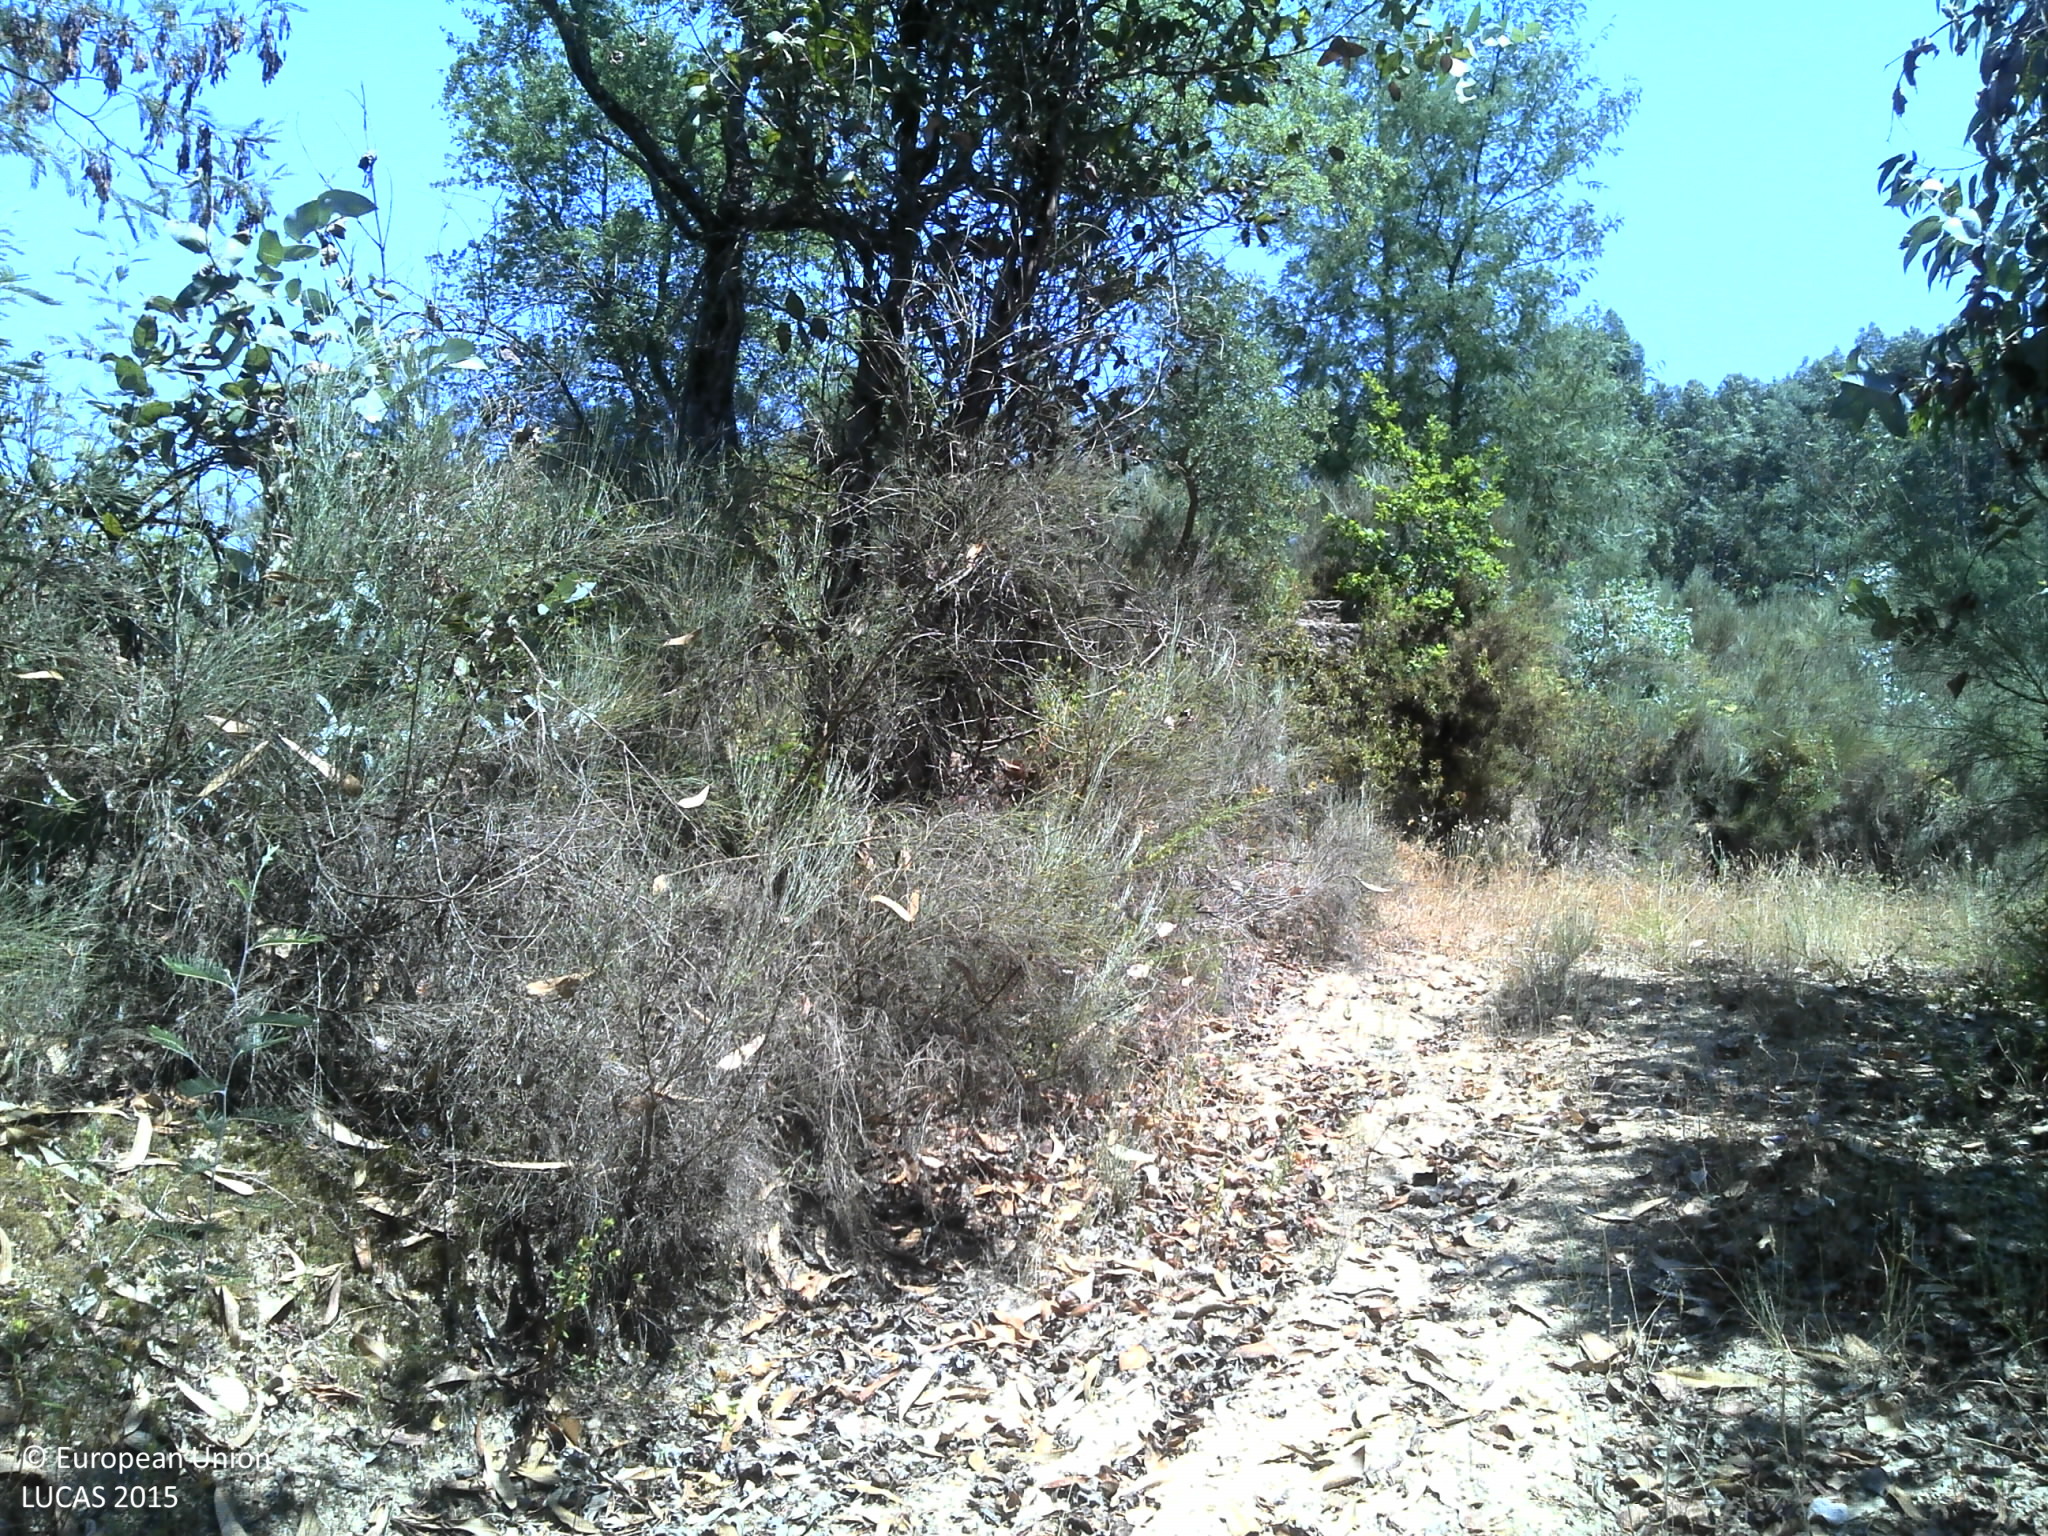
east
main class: Woodland
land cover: Broadleaved woodland
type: exotic forest
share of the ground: 50 - 75 %
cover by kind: broadleaved forest trees 75 %, shrubs 20 %, unconsolidated bare surface 5 %
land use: Forestry
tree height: > 5 m
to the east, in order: Broadleaved woodland; Tracks; Shrubland without tree cover; Broadleaved woodland; Tracks; Shrubland with sparse tree cover; Shrubland without tree cover; Broadleaved woodland; Shrubland with sparse tree cover
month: July
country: PT
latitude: 40.4029
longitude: -7.9725
